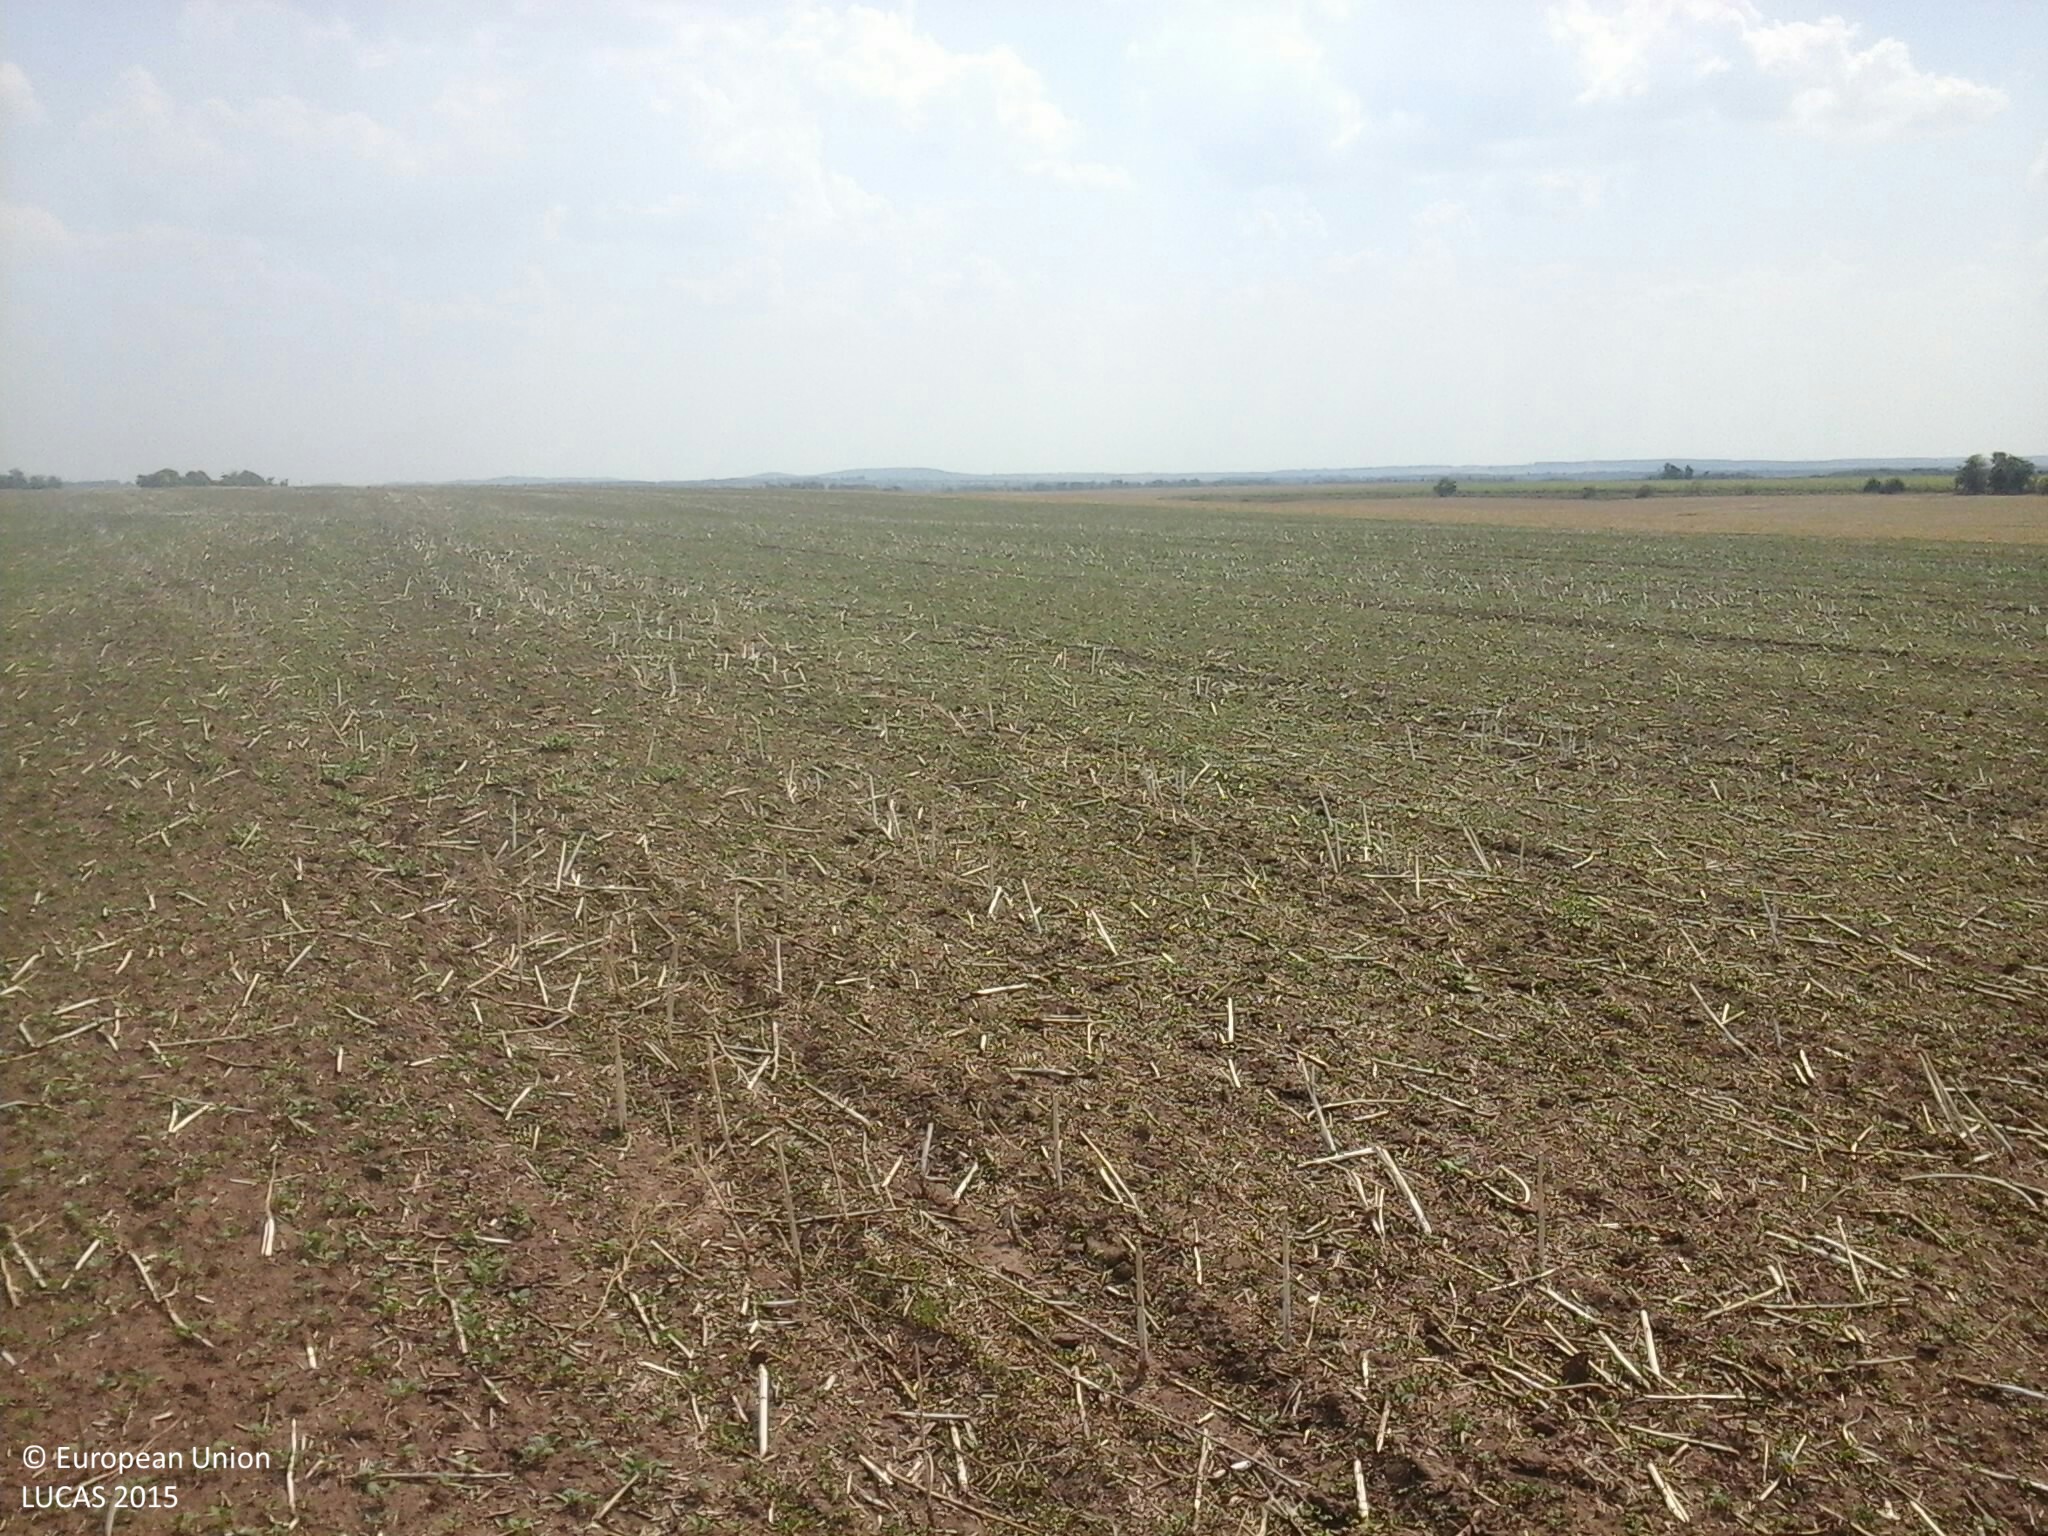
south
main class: Cropland
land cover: Rape and turnip rape
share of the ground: < 10 %
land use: Agriculture (excluding fallow land and kitchen gardens)
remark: Harvested field
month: August
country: HU
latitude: 46.8837
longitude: 18.2381
